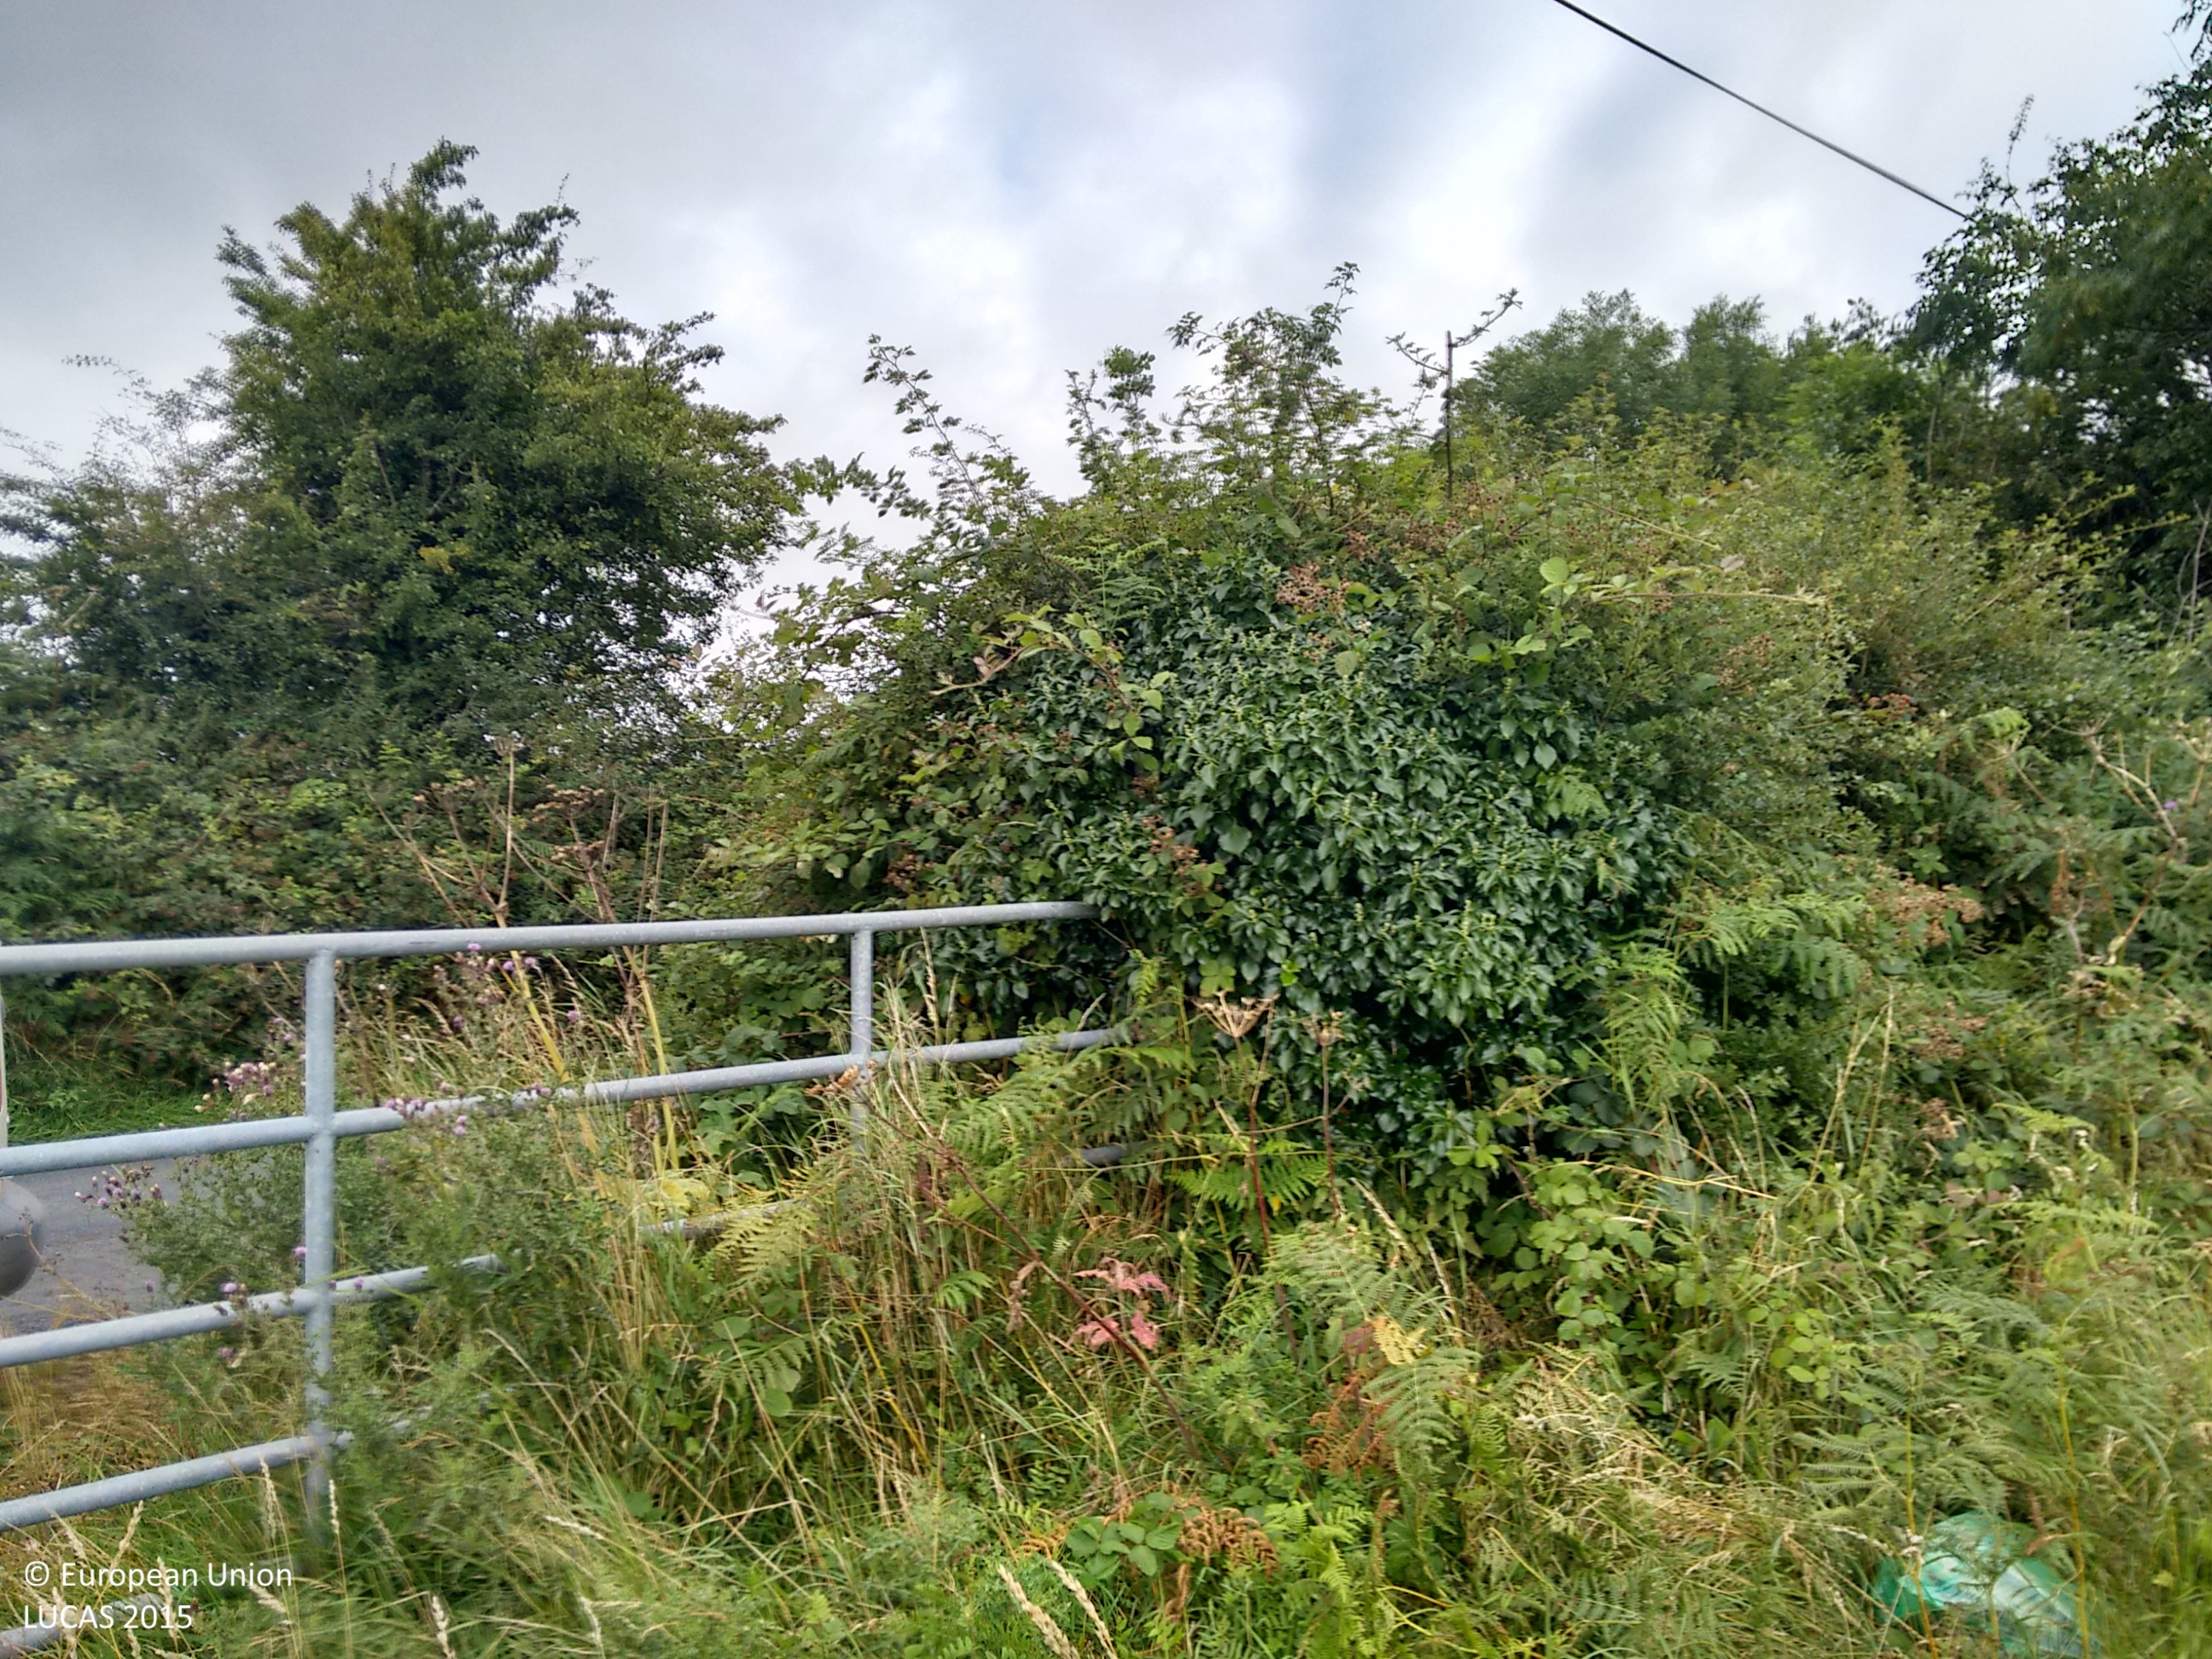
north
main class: Cropland
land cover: Oats
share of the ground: > 75 %
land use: Agriculture (excluding fallow land and kitchen gardens)
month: August
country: IE
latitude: 52.5210
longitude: -6.5927
